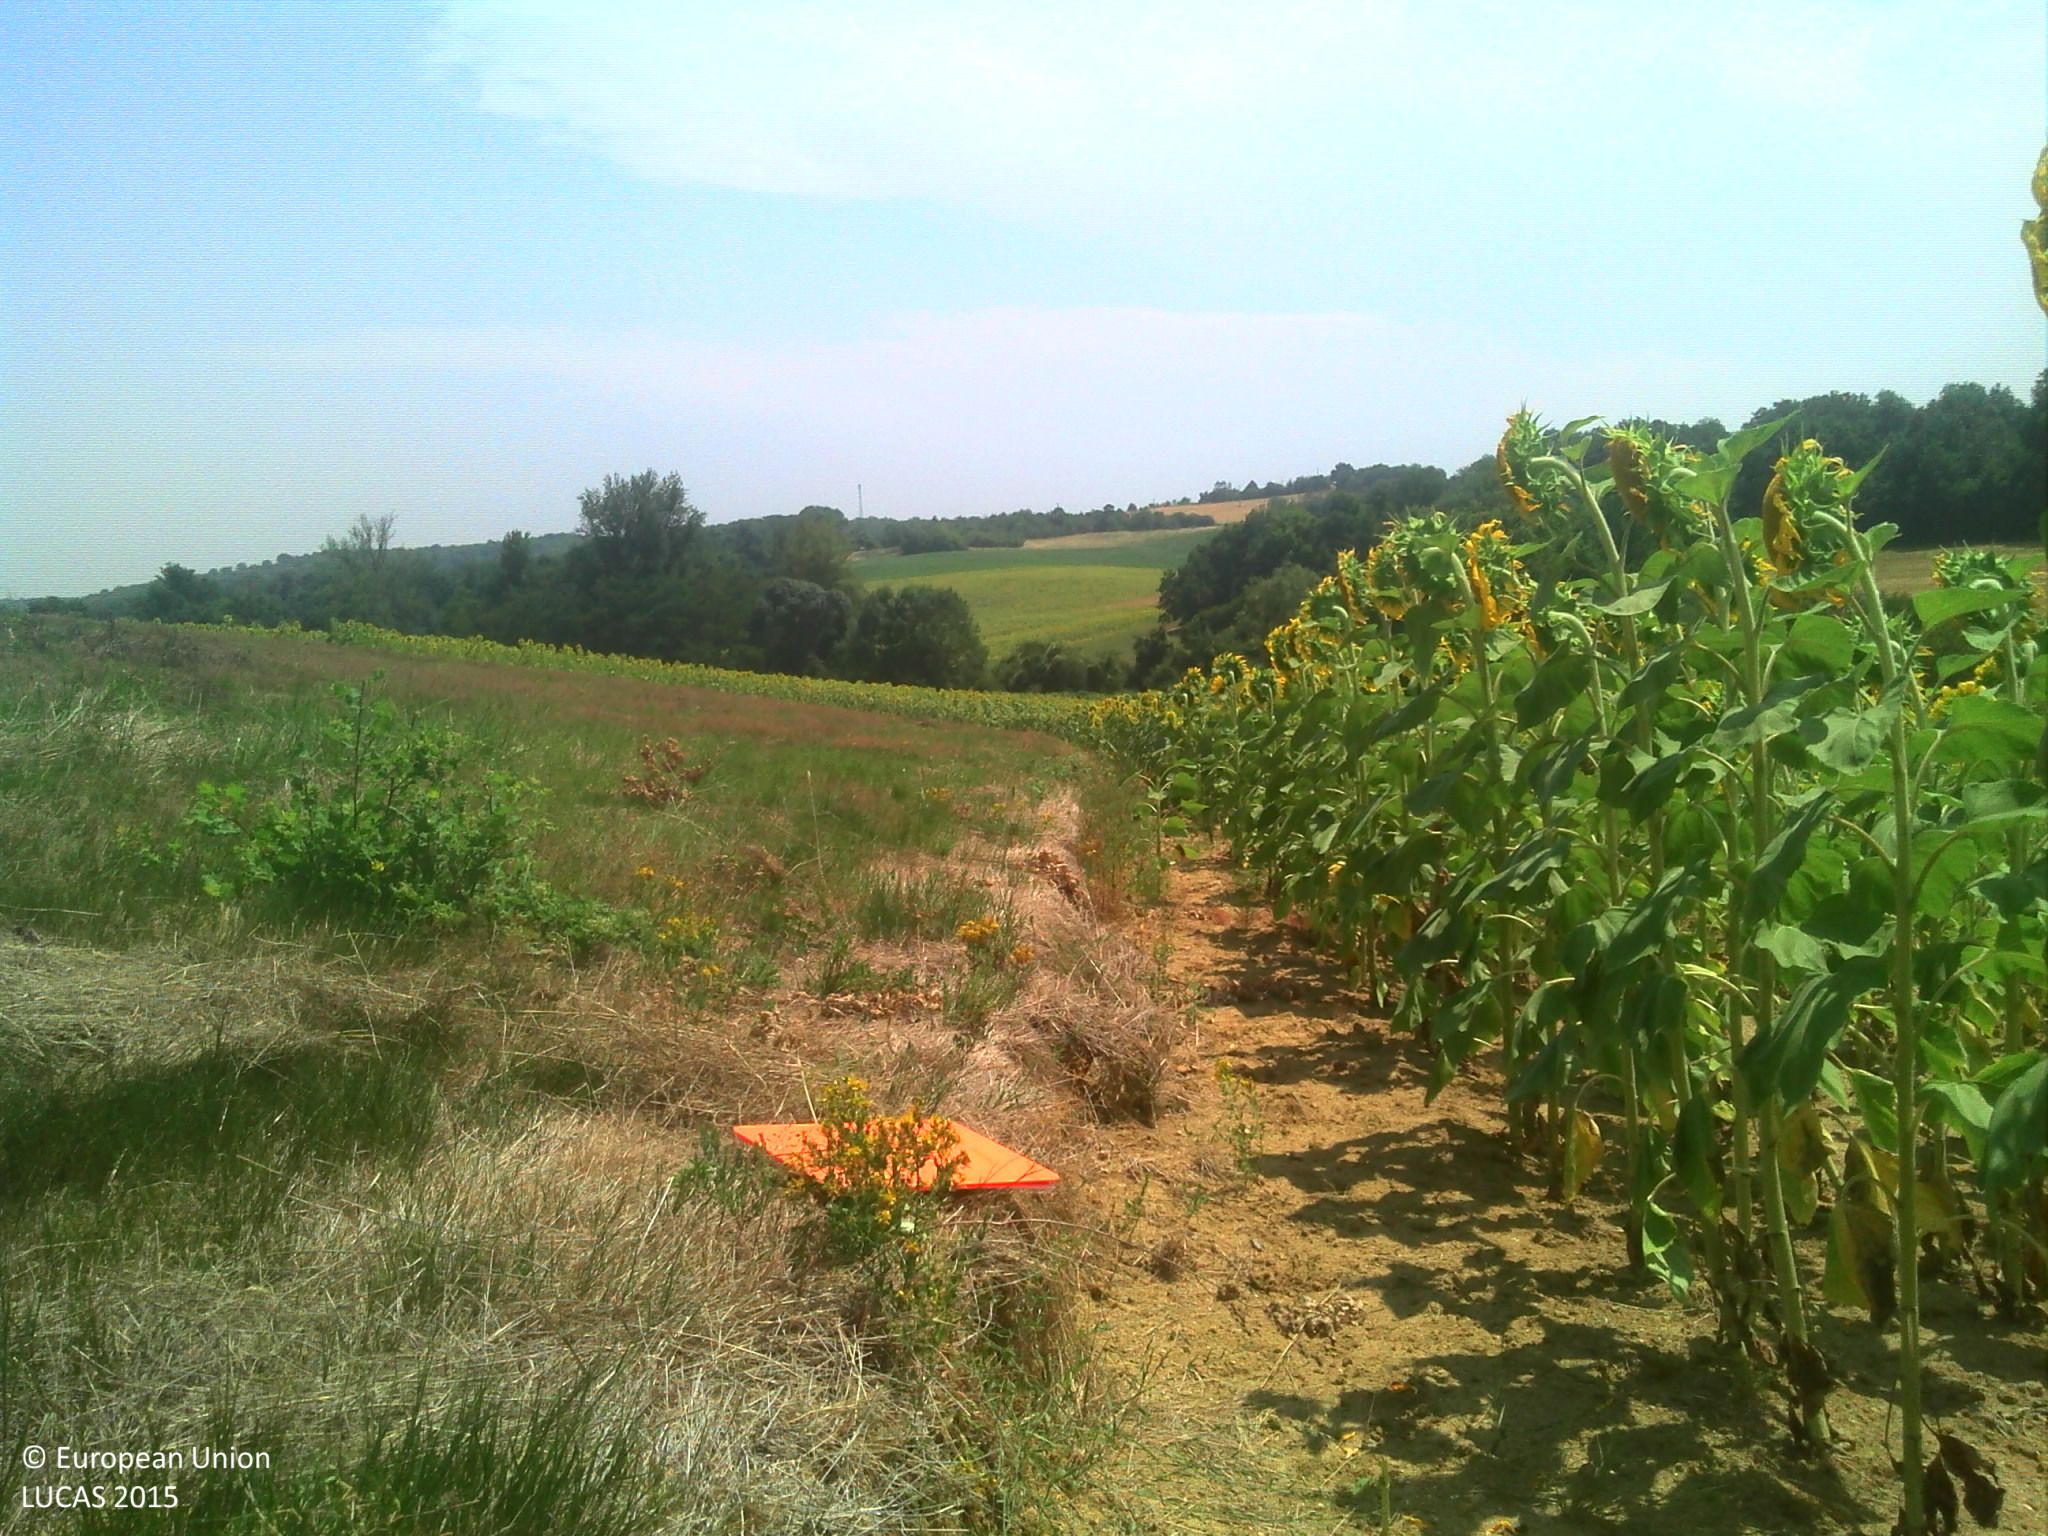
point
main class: Grassland
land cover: Grassland without tree/shrub cover
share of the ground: > 75 %
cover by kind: herbaceous plants 100 %
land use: Agriculture (excluding fallow land and kitchen gardens)
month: July
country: FR
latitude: 43.3807
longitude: 1.0283
